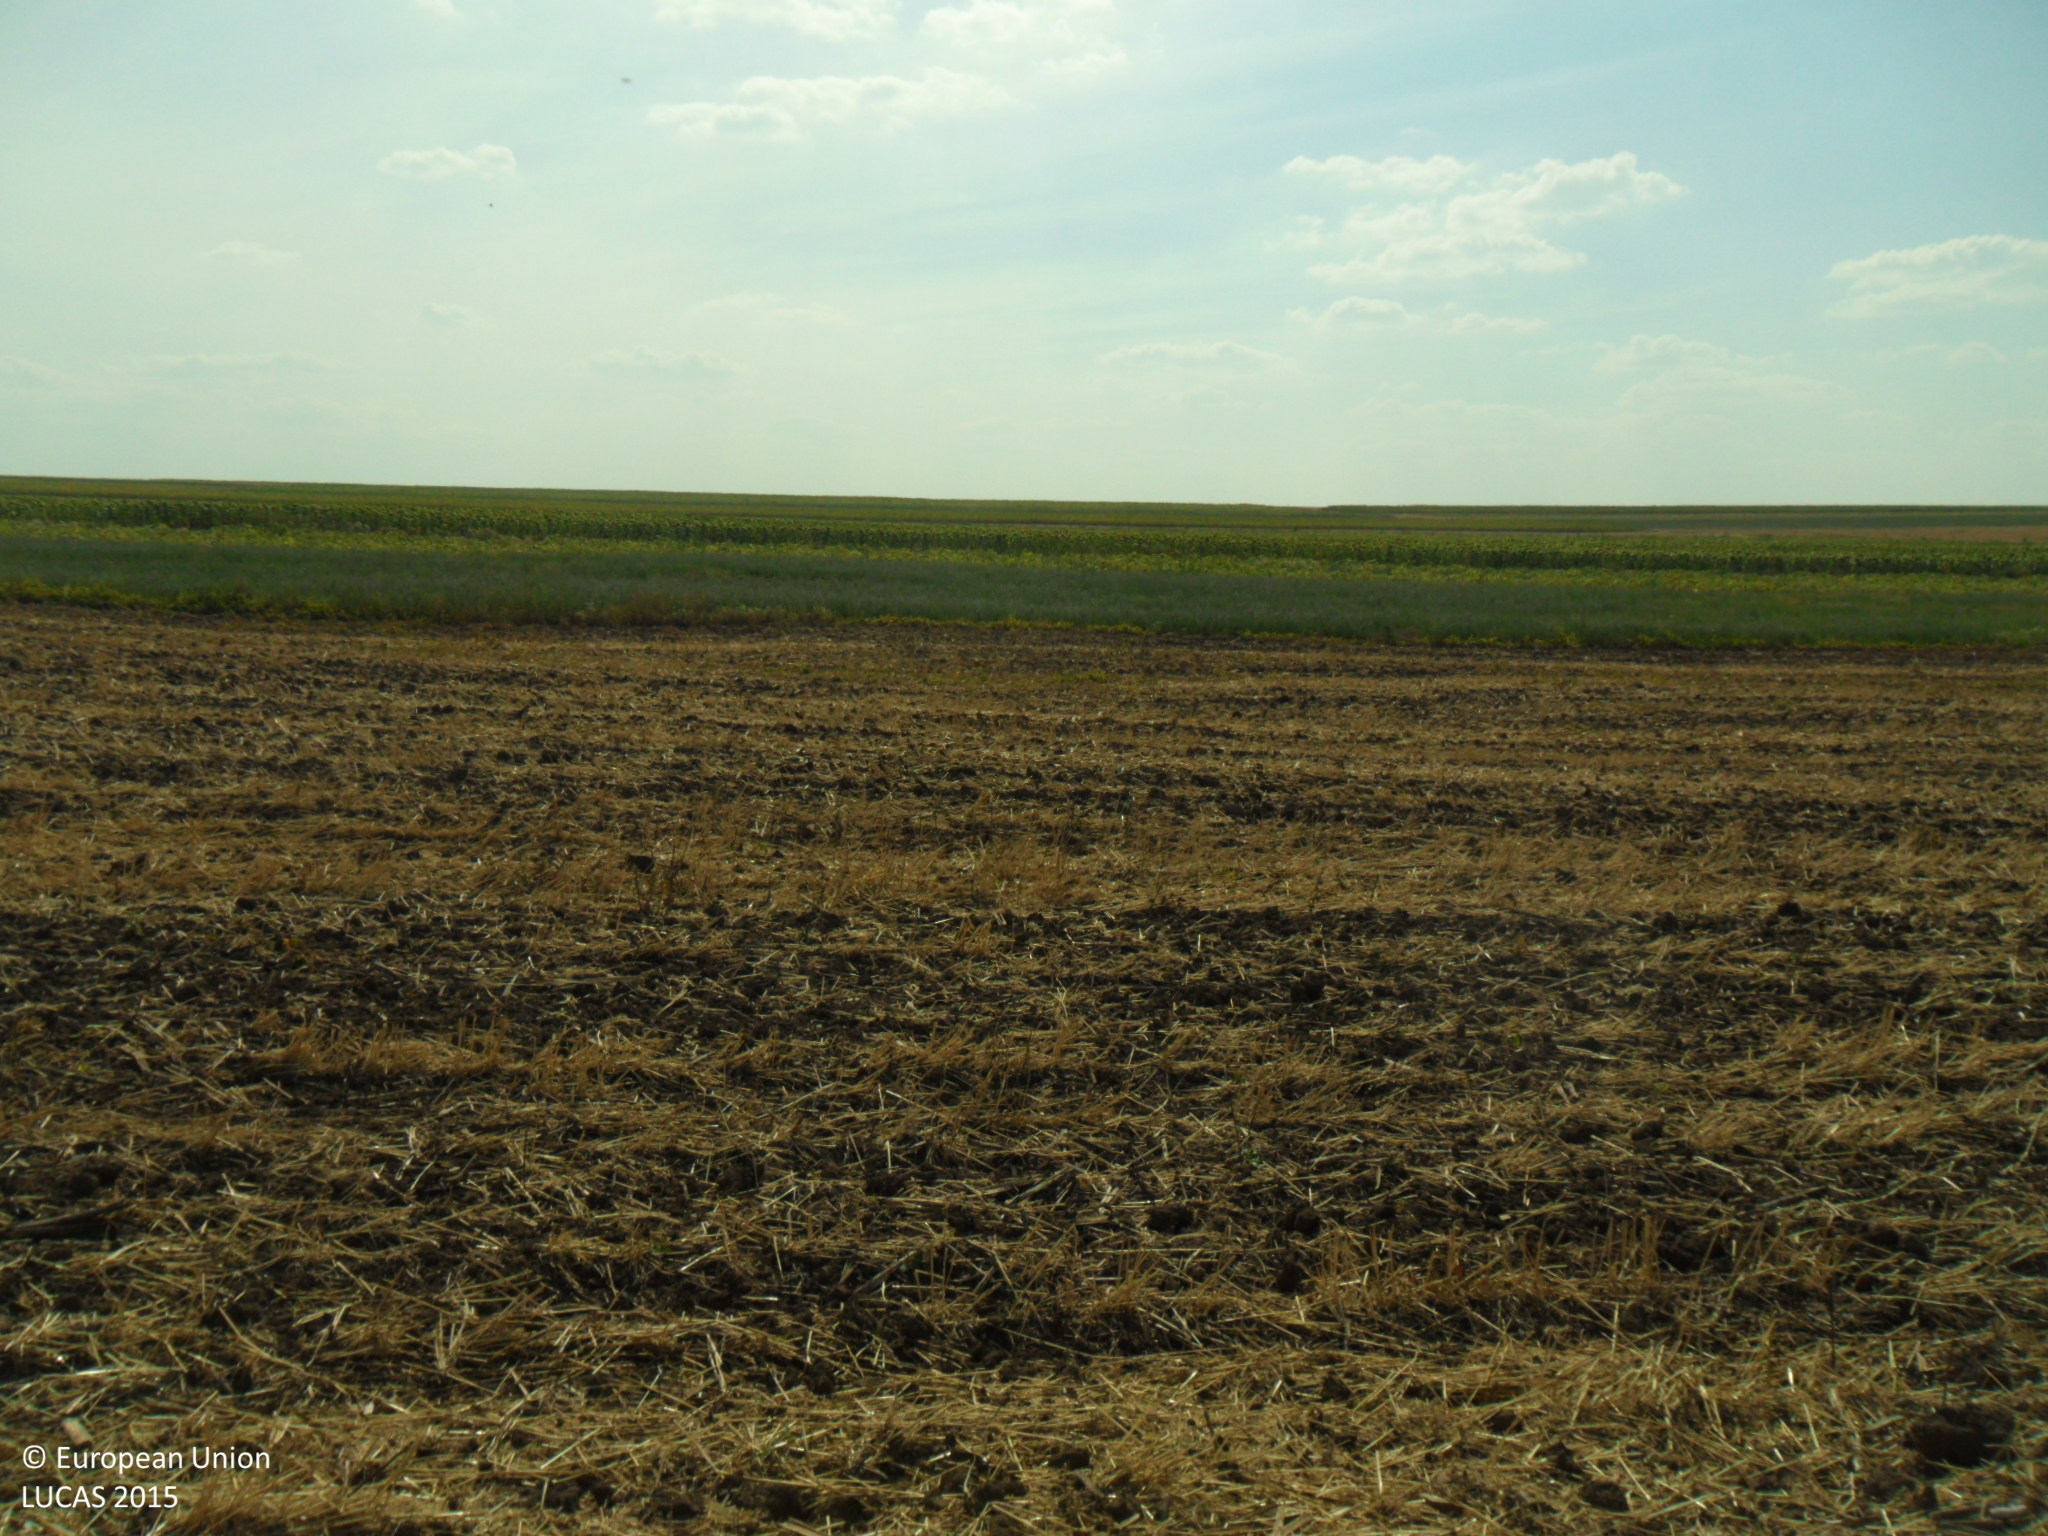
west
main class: Cropland
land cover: Common wheat
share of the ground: < 10 %
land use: Agriculture (excluding fallow land and kitchen gardens)
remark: Harvested field
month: August
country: BG
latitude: 43.6294
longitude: 27.1396
